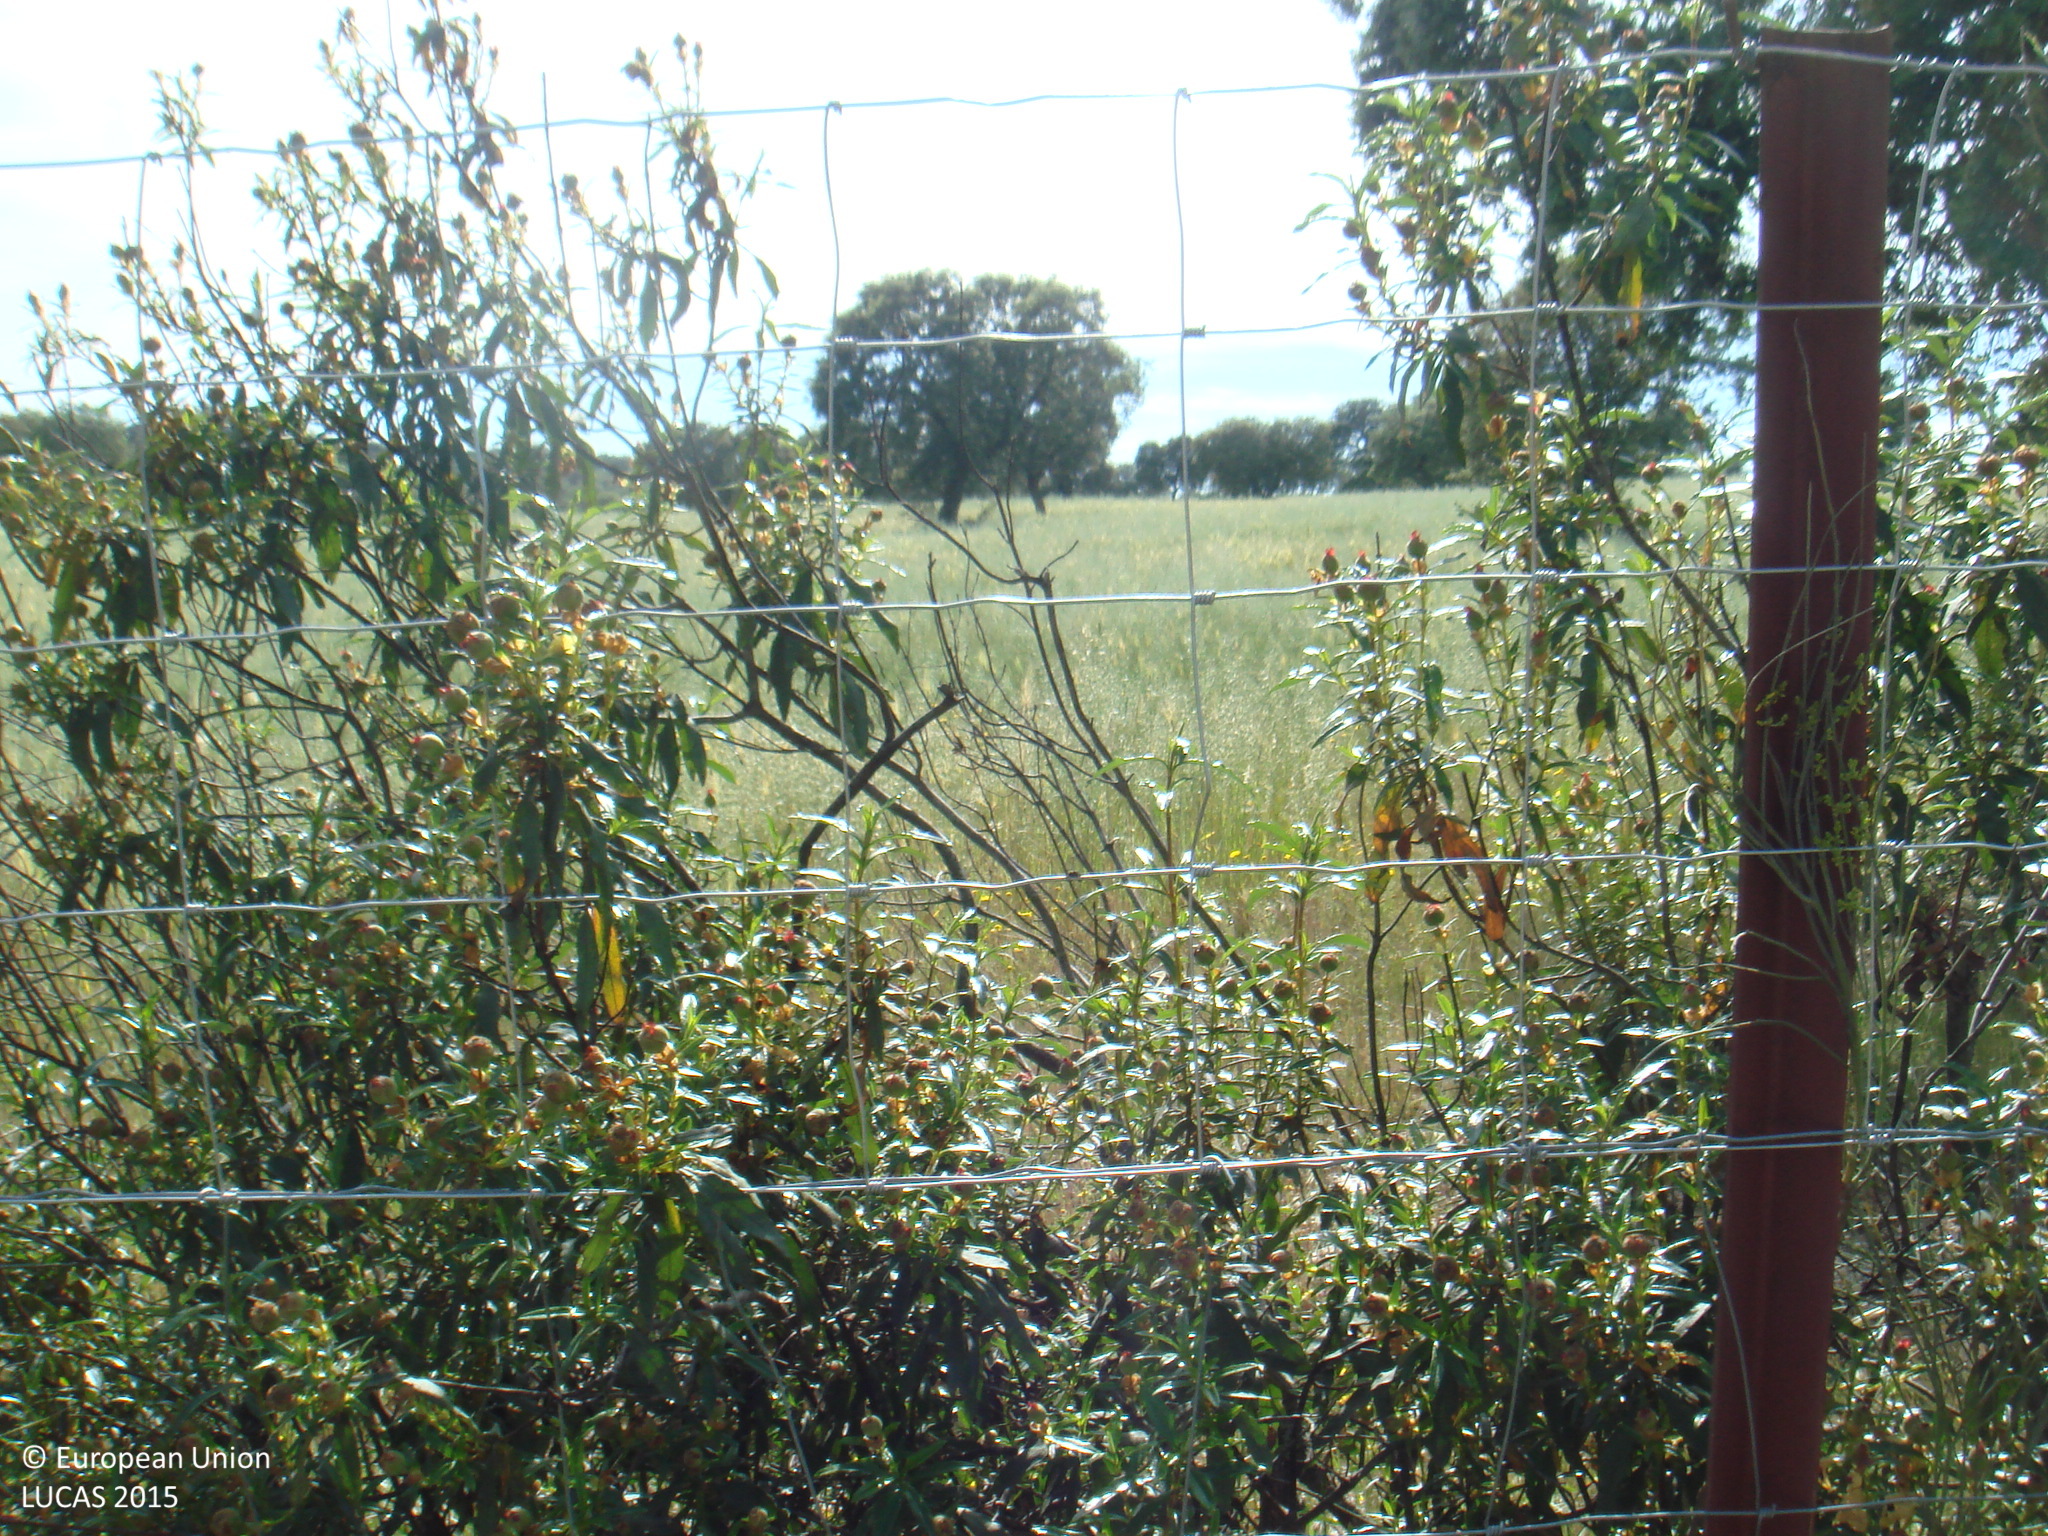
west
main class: Woodland
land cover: Broadleaved woodland
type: broadleaved evergreen forest
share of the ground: 10 - 25 %
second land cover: Oats
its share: > 75 %
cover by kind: herbaceous plants 85 %, broadleaved forest trees 15 %
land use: Forestry
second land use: Agriculture (excluding fallow land and kitchen gardens)
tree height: > 5 m
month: April
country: ES
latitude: 38.4094
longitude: -5.1101
